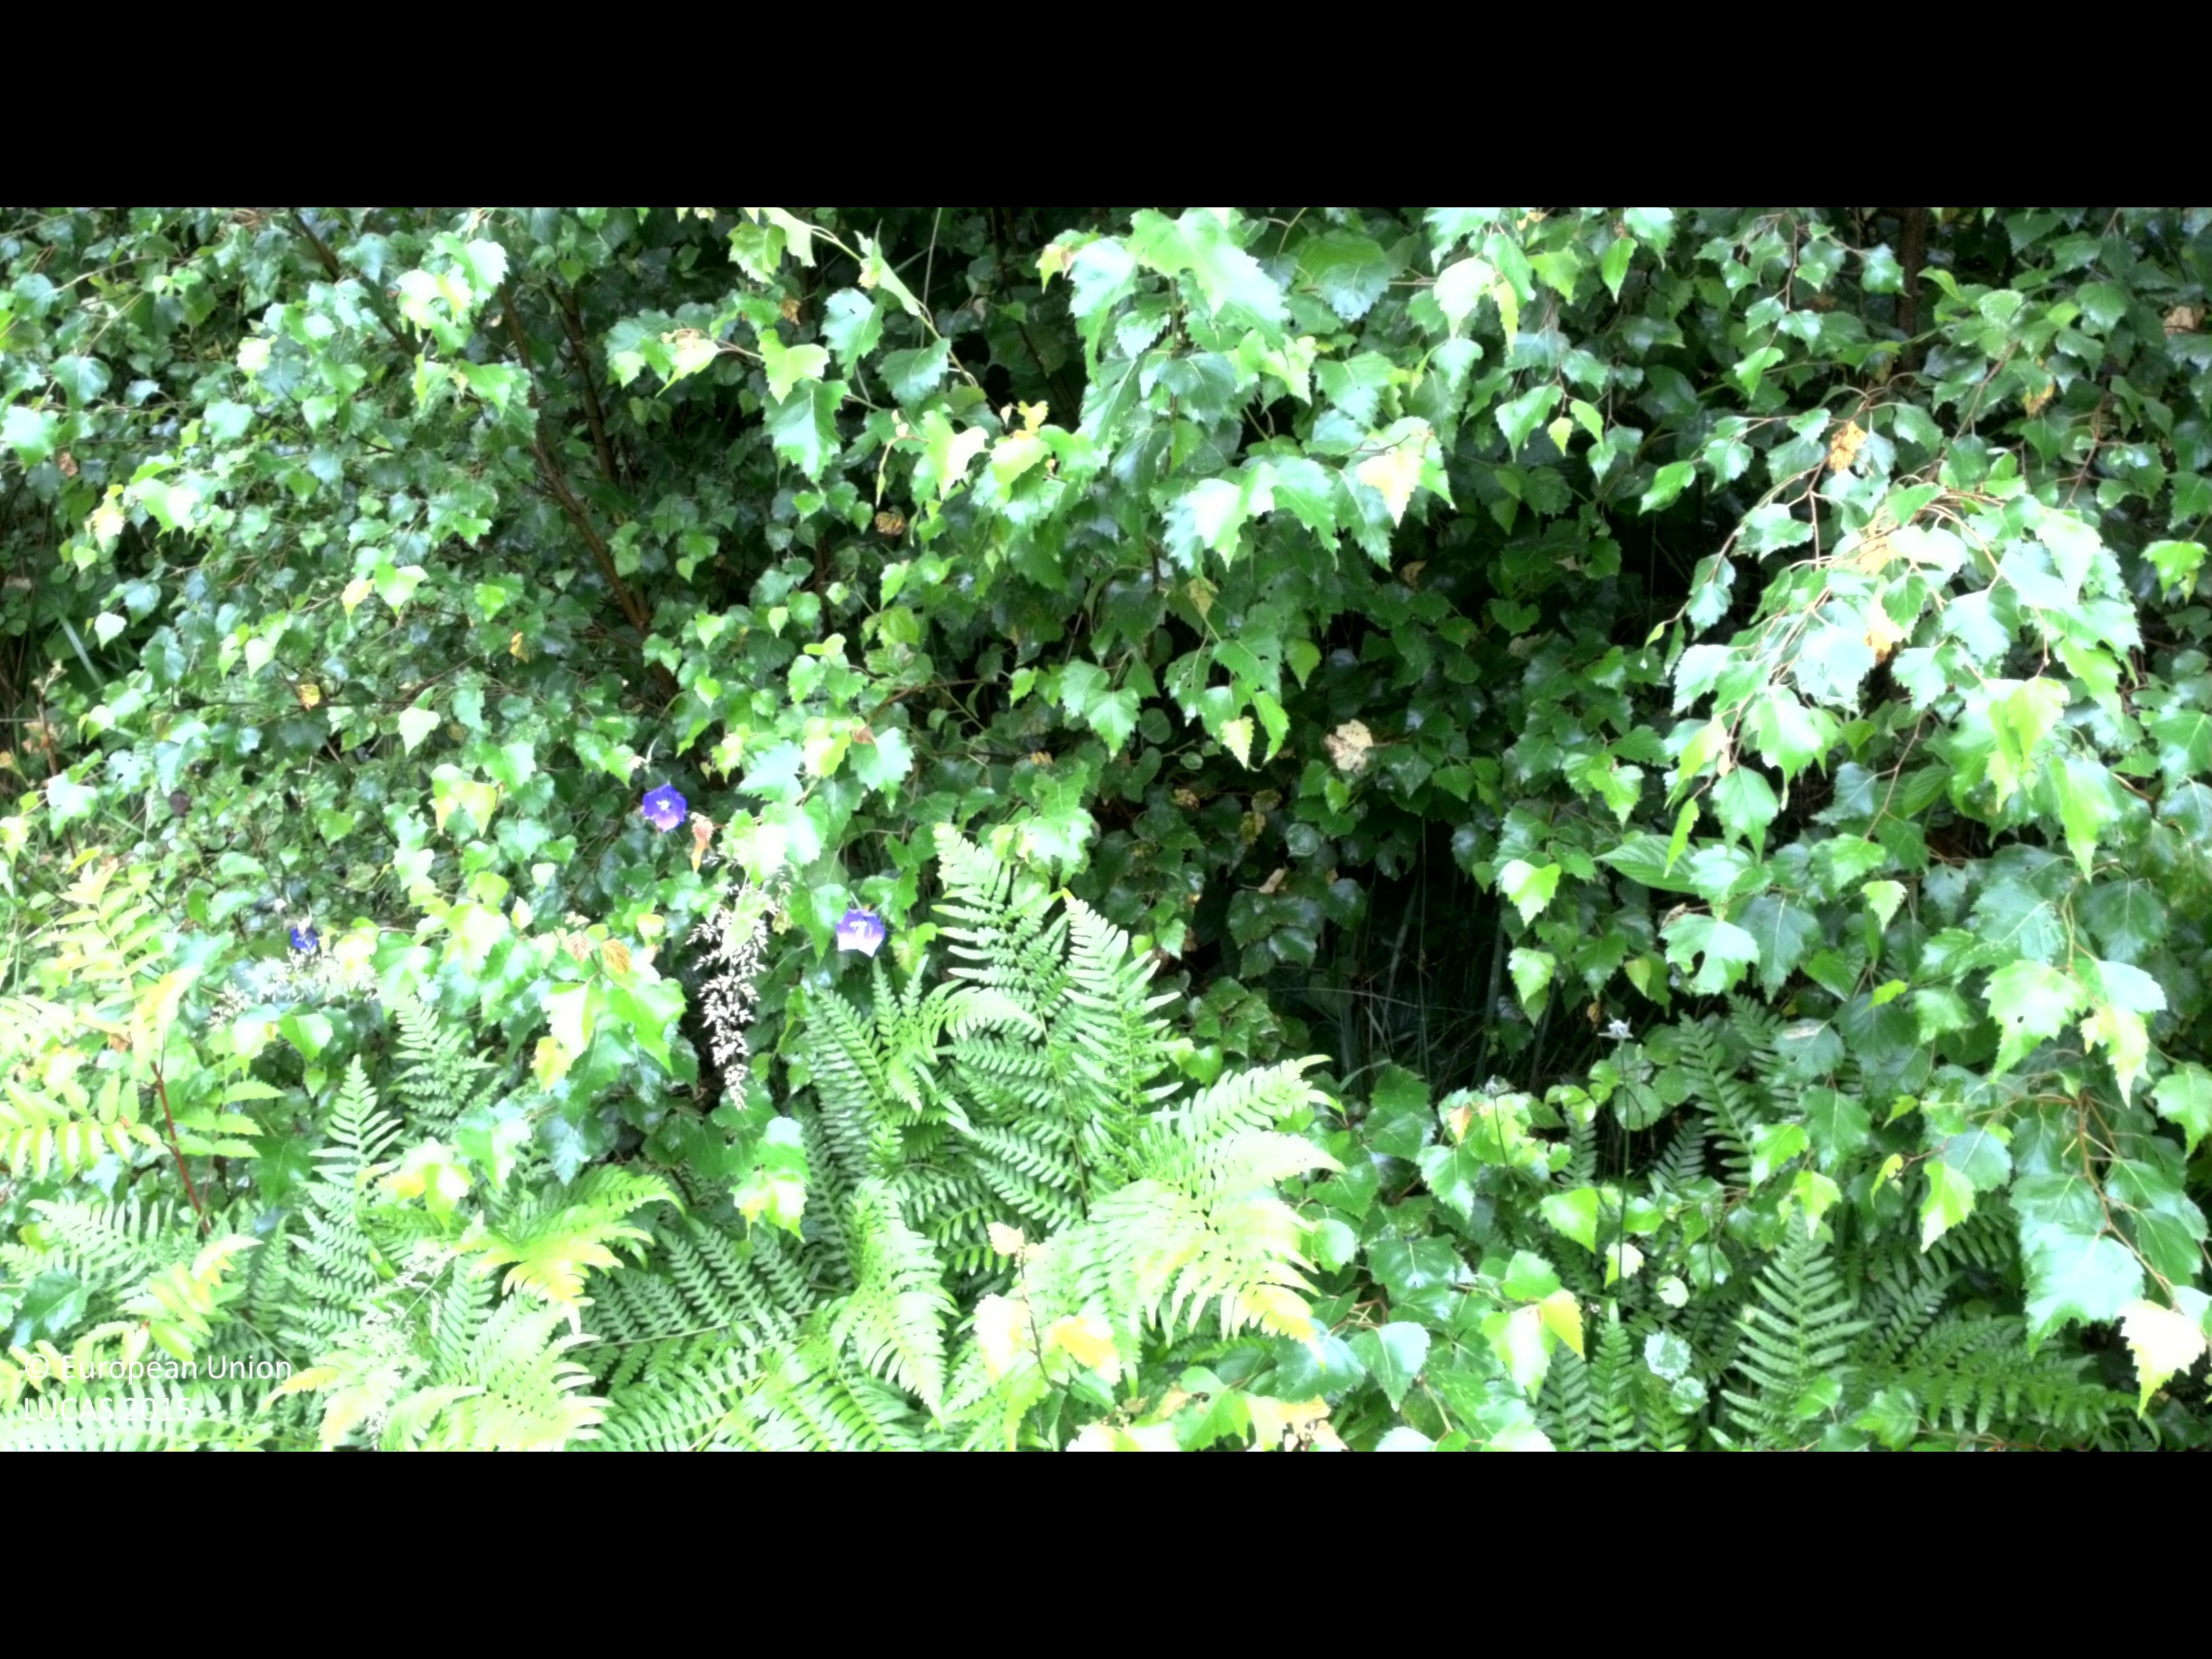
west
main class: Cropland
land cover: Rye
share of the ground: > 75 %
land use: Agriculture (excluding fallow land and kitchen gardens)
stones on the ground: < 10 %
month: July
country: SE
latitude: 58.3457
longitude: 16.2317
